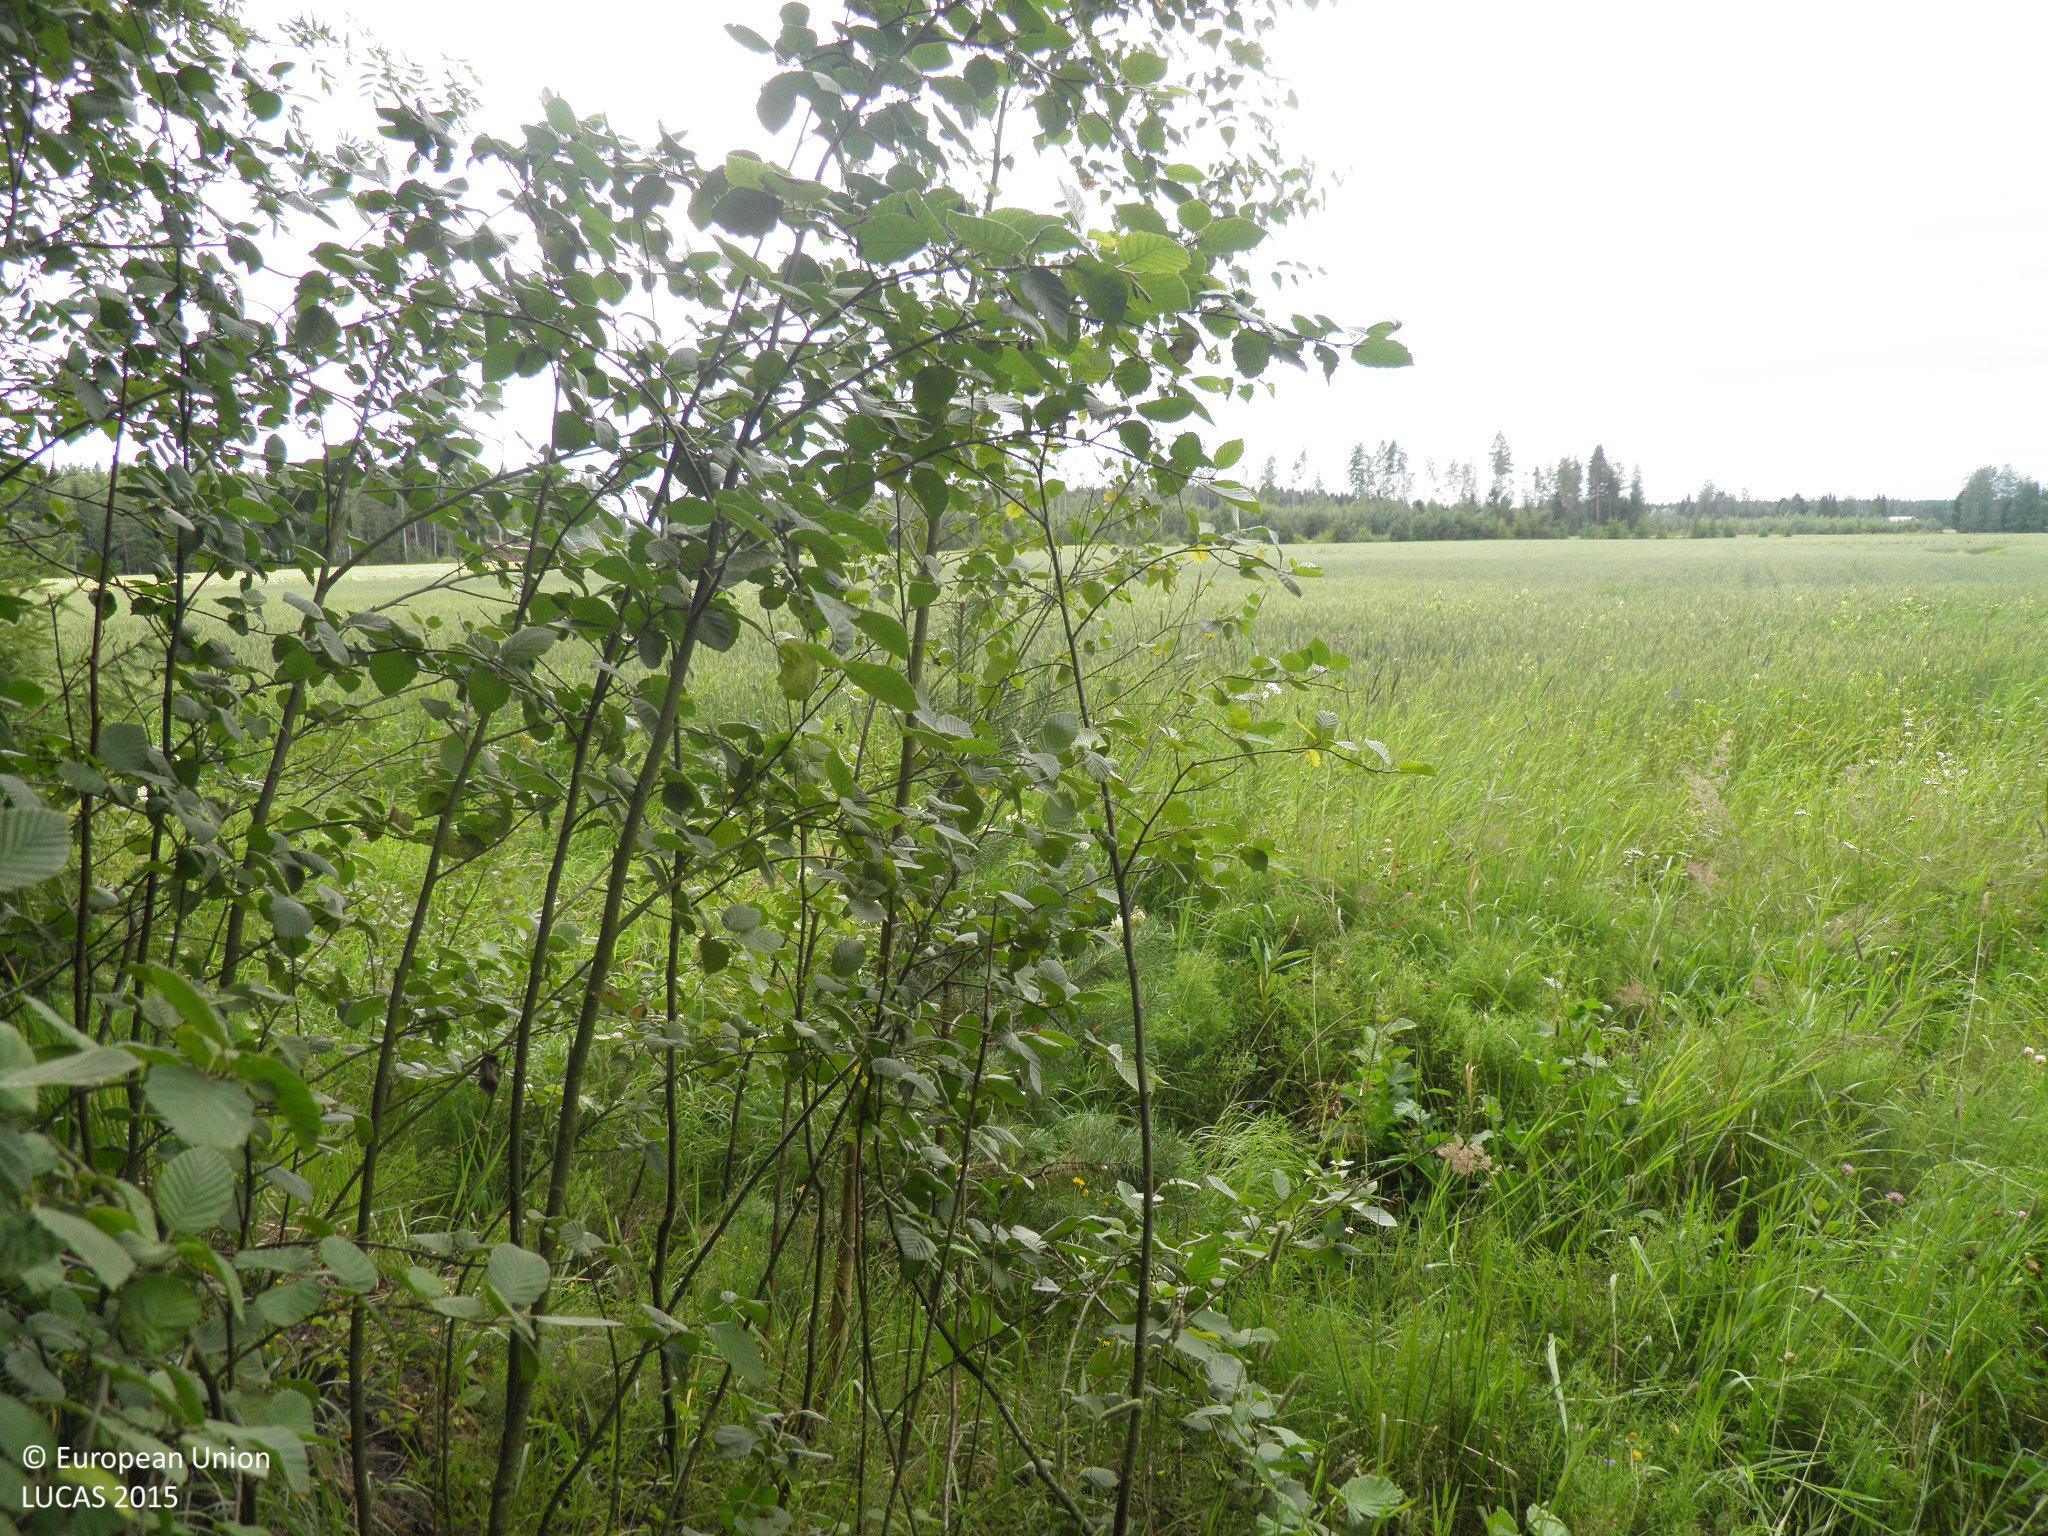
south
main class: Woodland
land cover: Spruce dominated coniferous woodland
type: boreal forest
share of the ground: 50 - 75 %
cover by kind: coniferous forest trees 60 %, broadleaved forest trees 10 %, shrubs 10 %, herbaceous plants 10 %, lichens and mosses 10 %
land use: Forestry
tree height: > 5 m
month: August
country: FI
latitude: 61.0748
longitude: 22.8041
